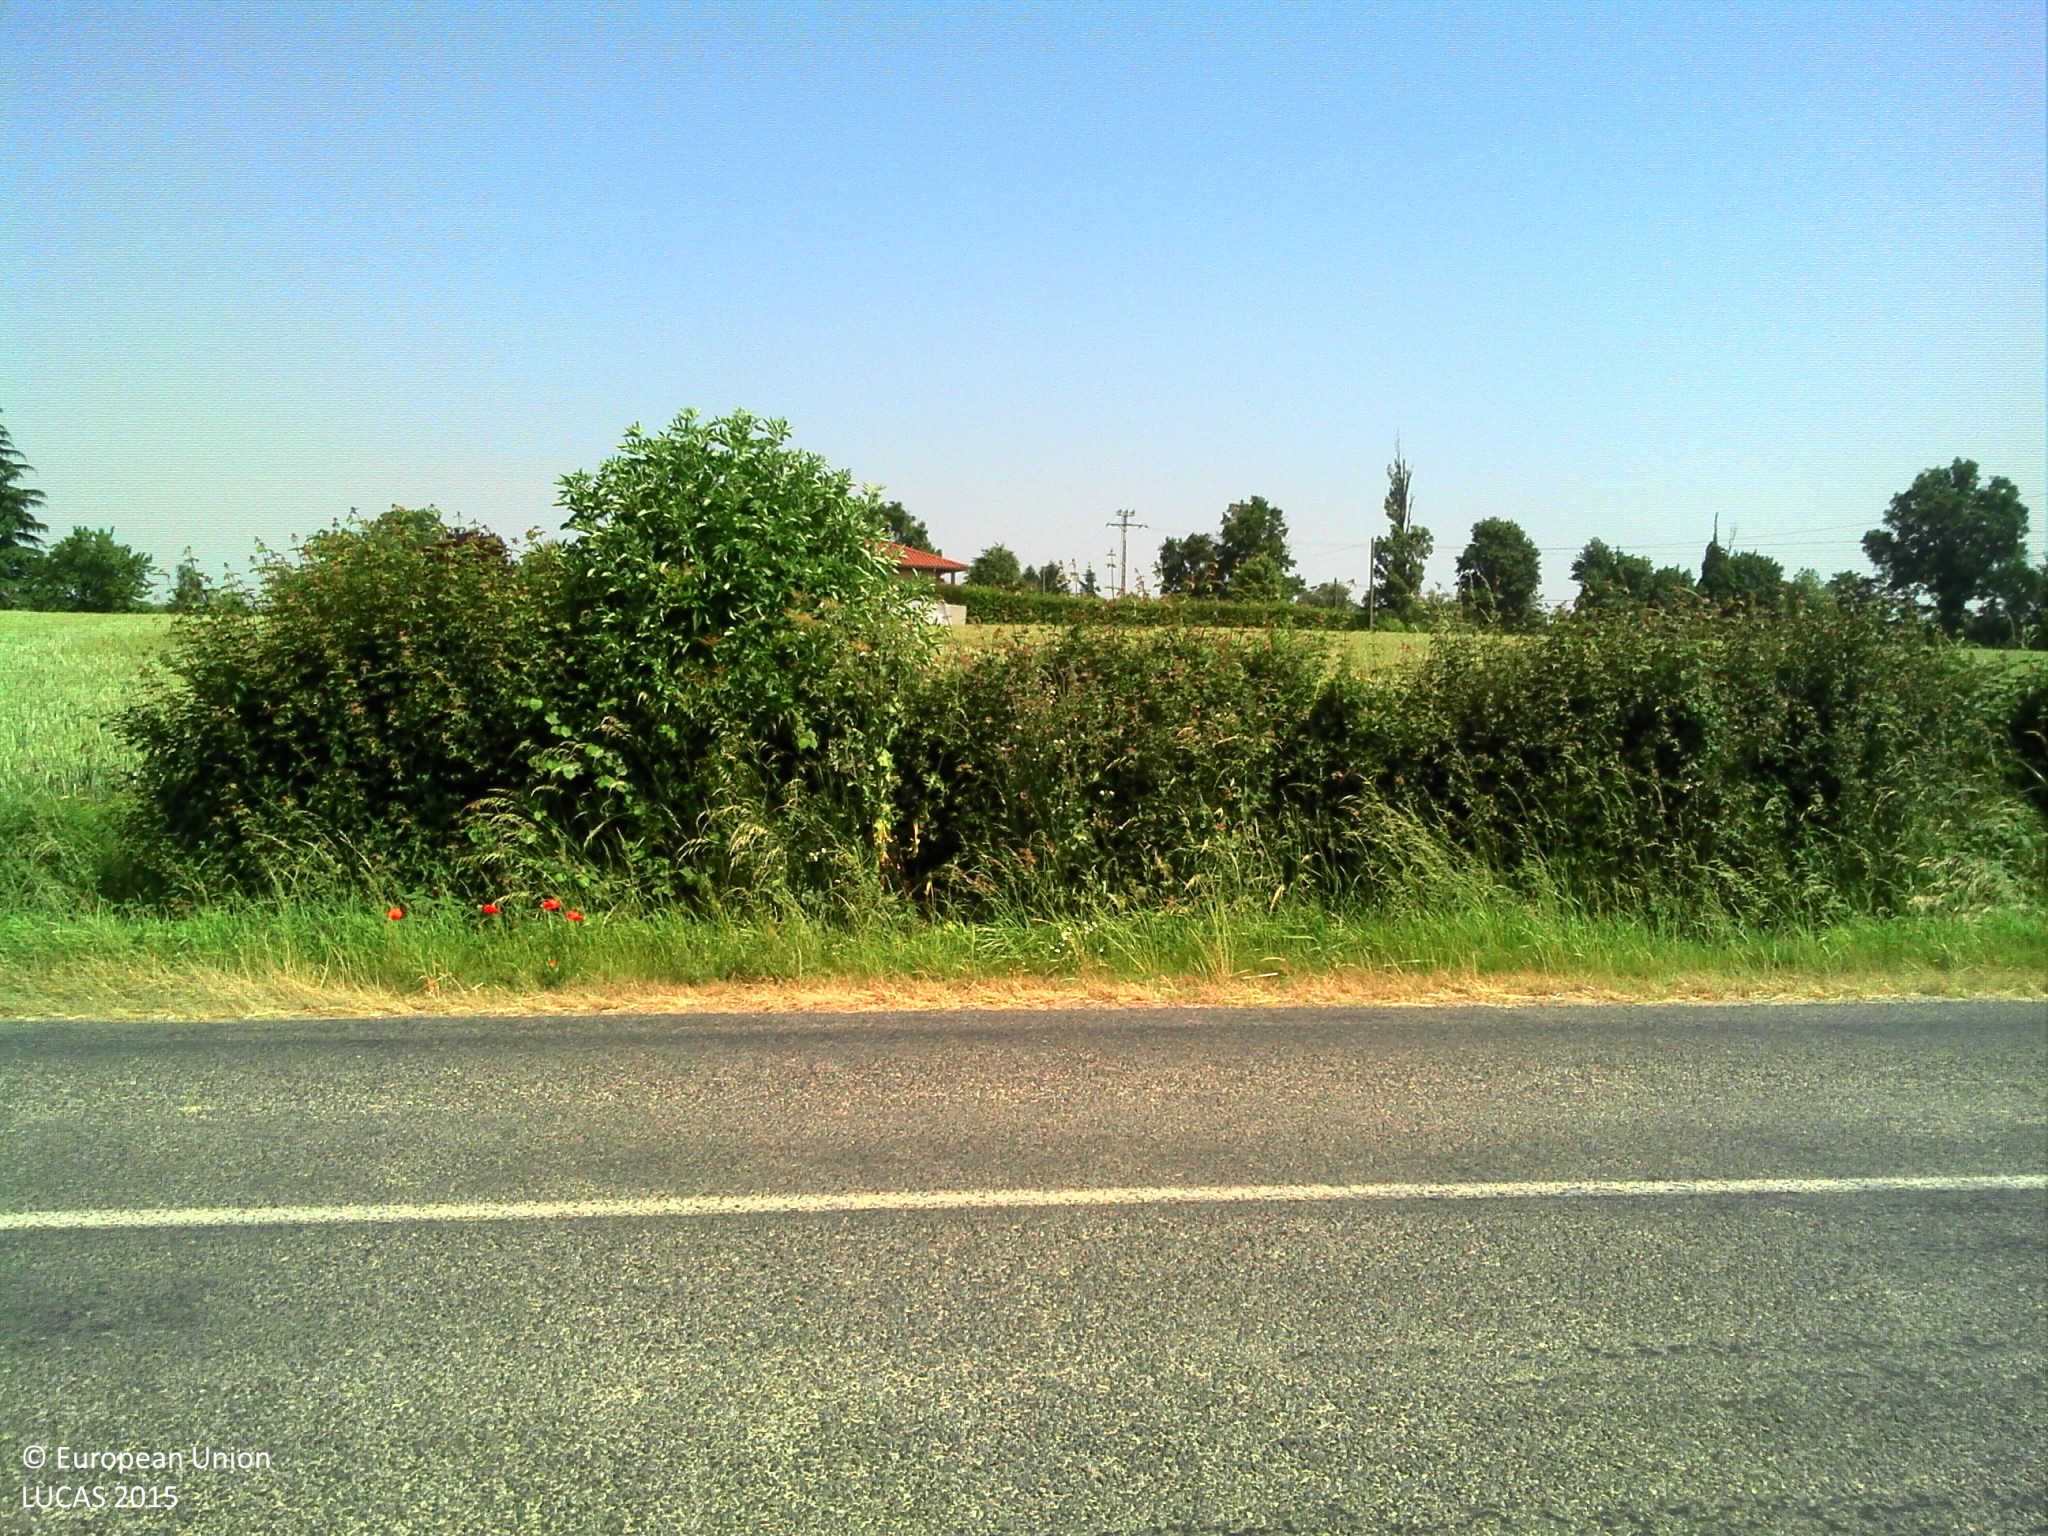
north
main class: Cropland
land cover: Rape and turnip rape
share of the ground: > 75 %
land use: Agriculture (excluding fallow land and kitchen gardens)
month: June
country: FR
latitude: 45.9579
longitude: 4.8808
